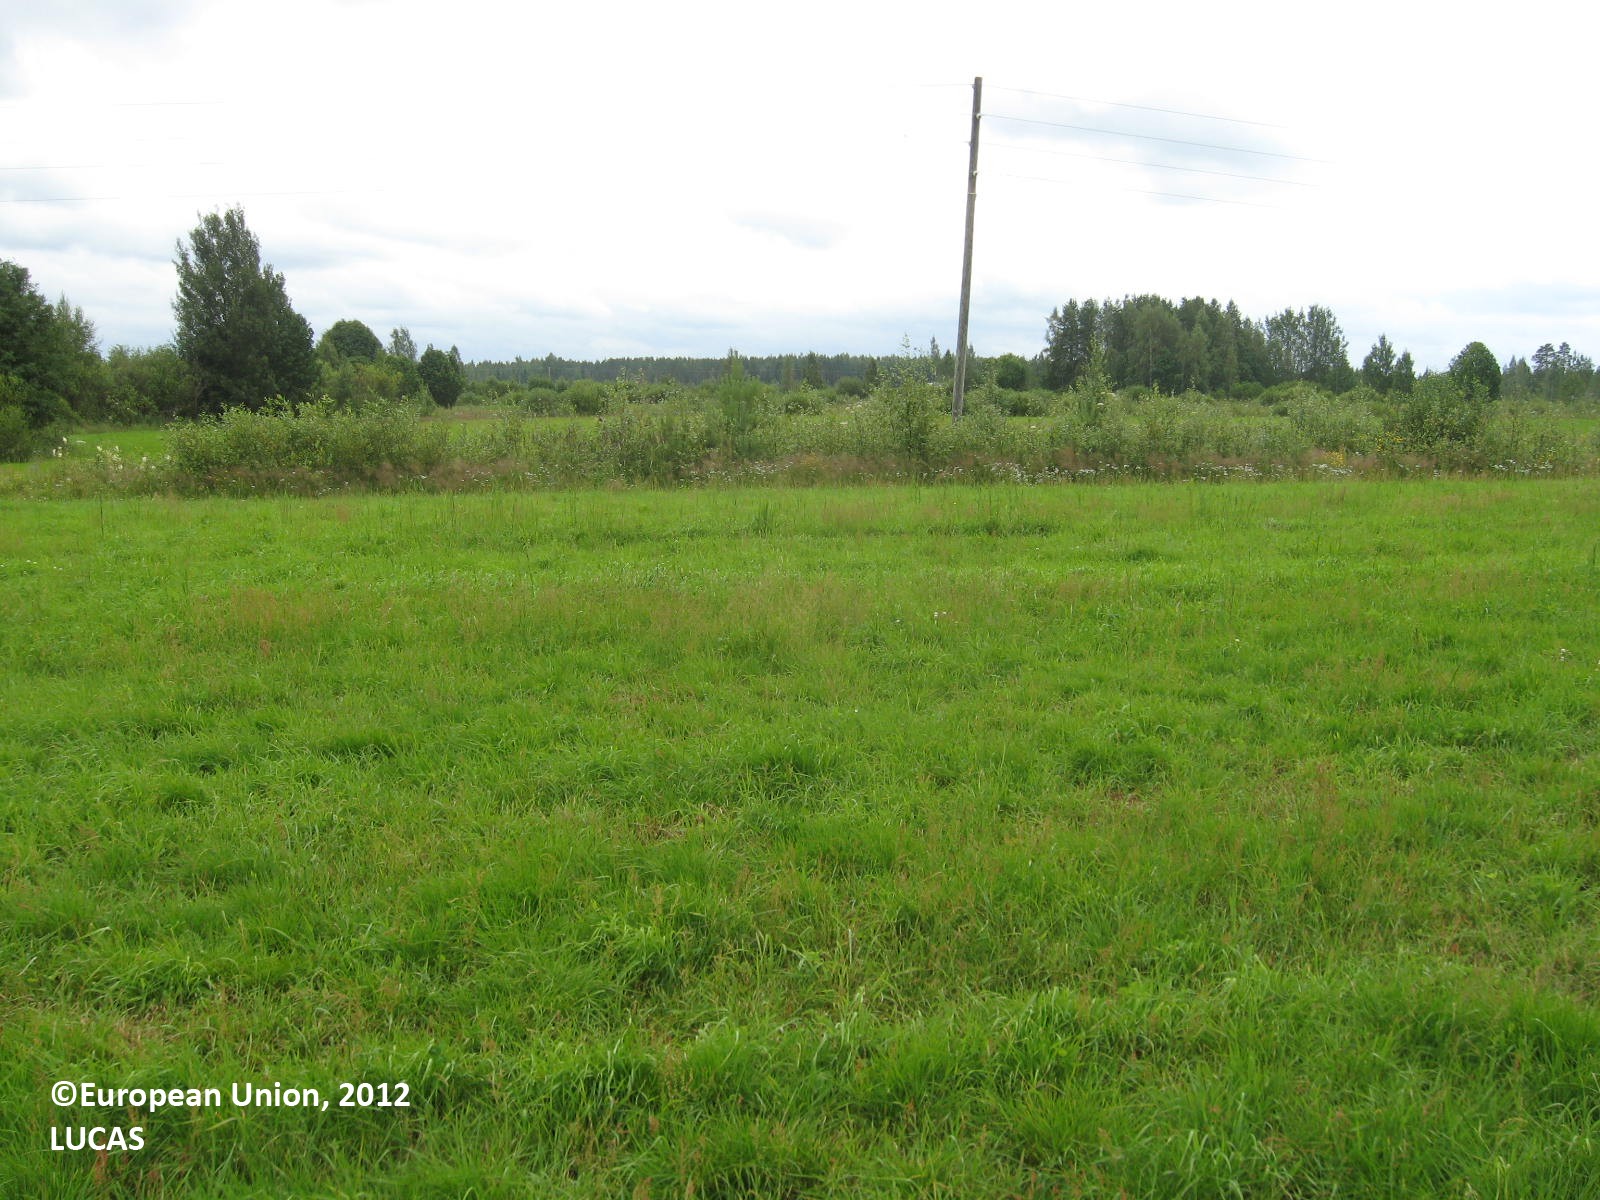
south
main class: Cropland
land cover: Temporary grasslands
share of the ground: > 75 %
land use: Agriculture (excluding fallow land and kitchen gardens)
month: July
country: FI
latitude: 62.1946
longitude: 22.7640
